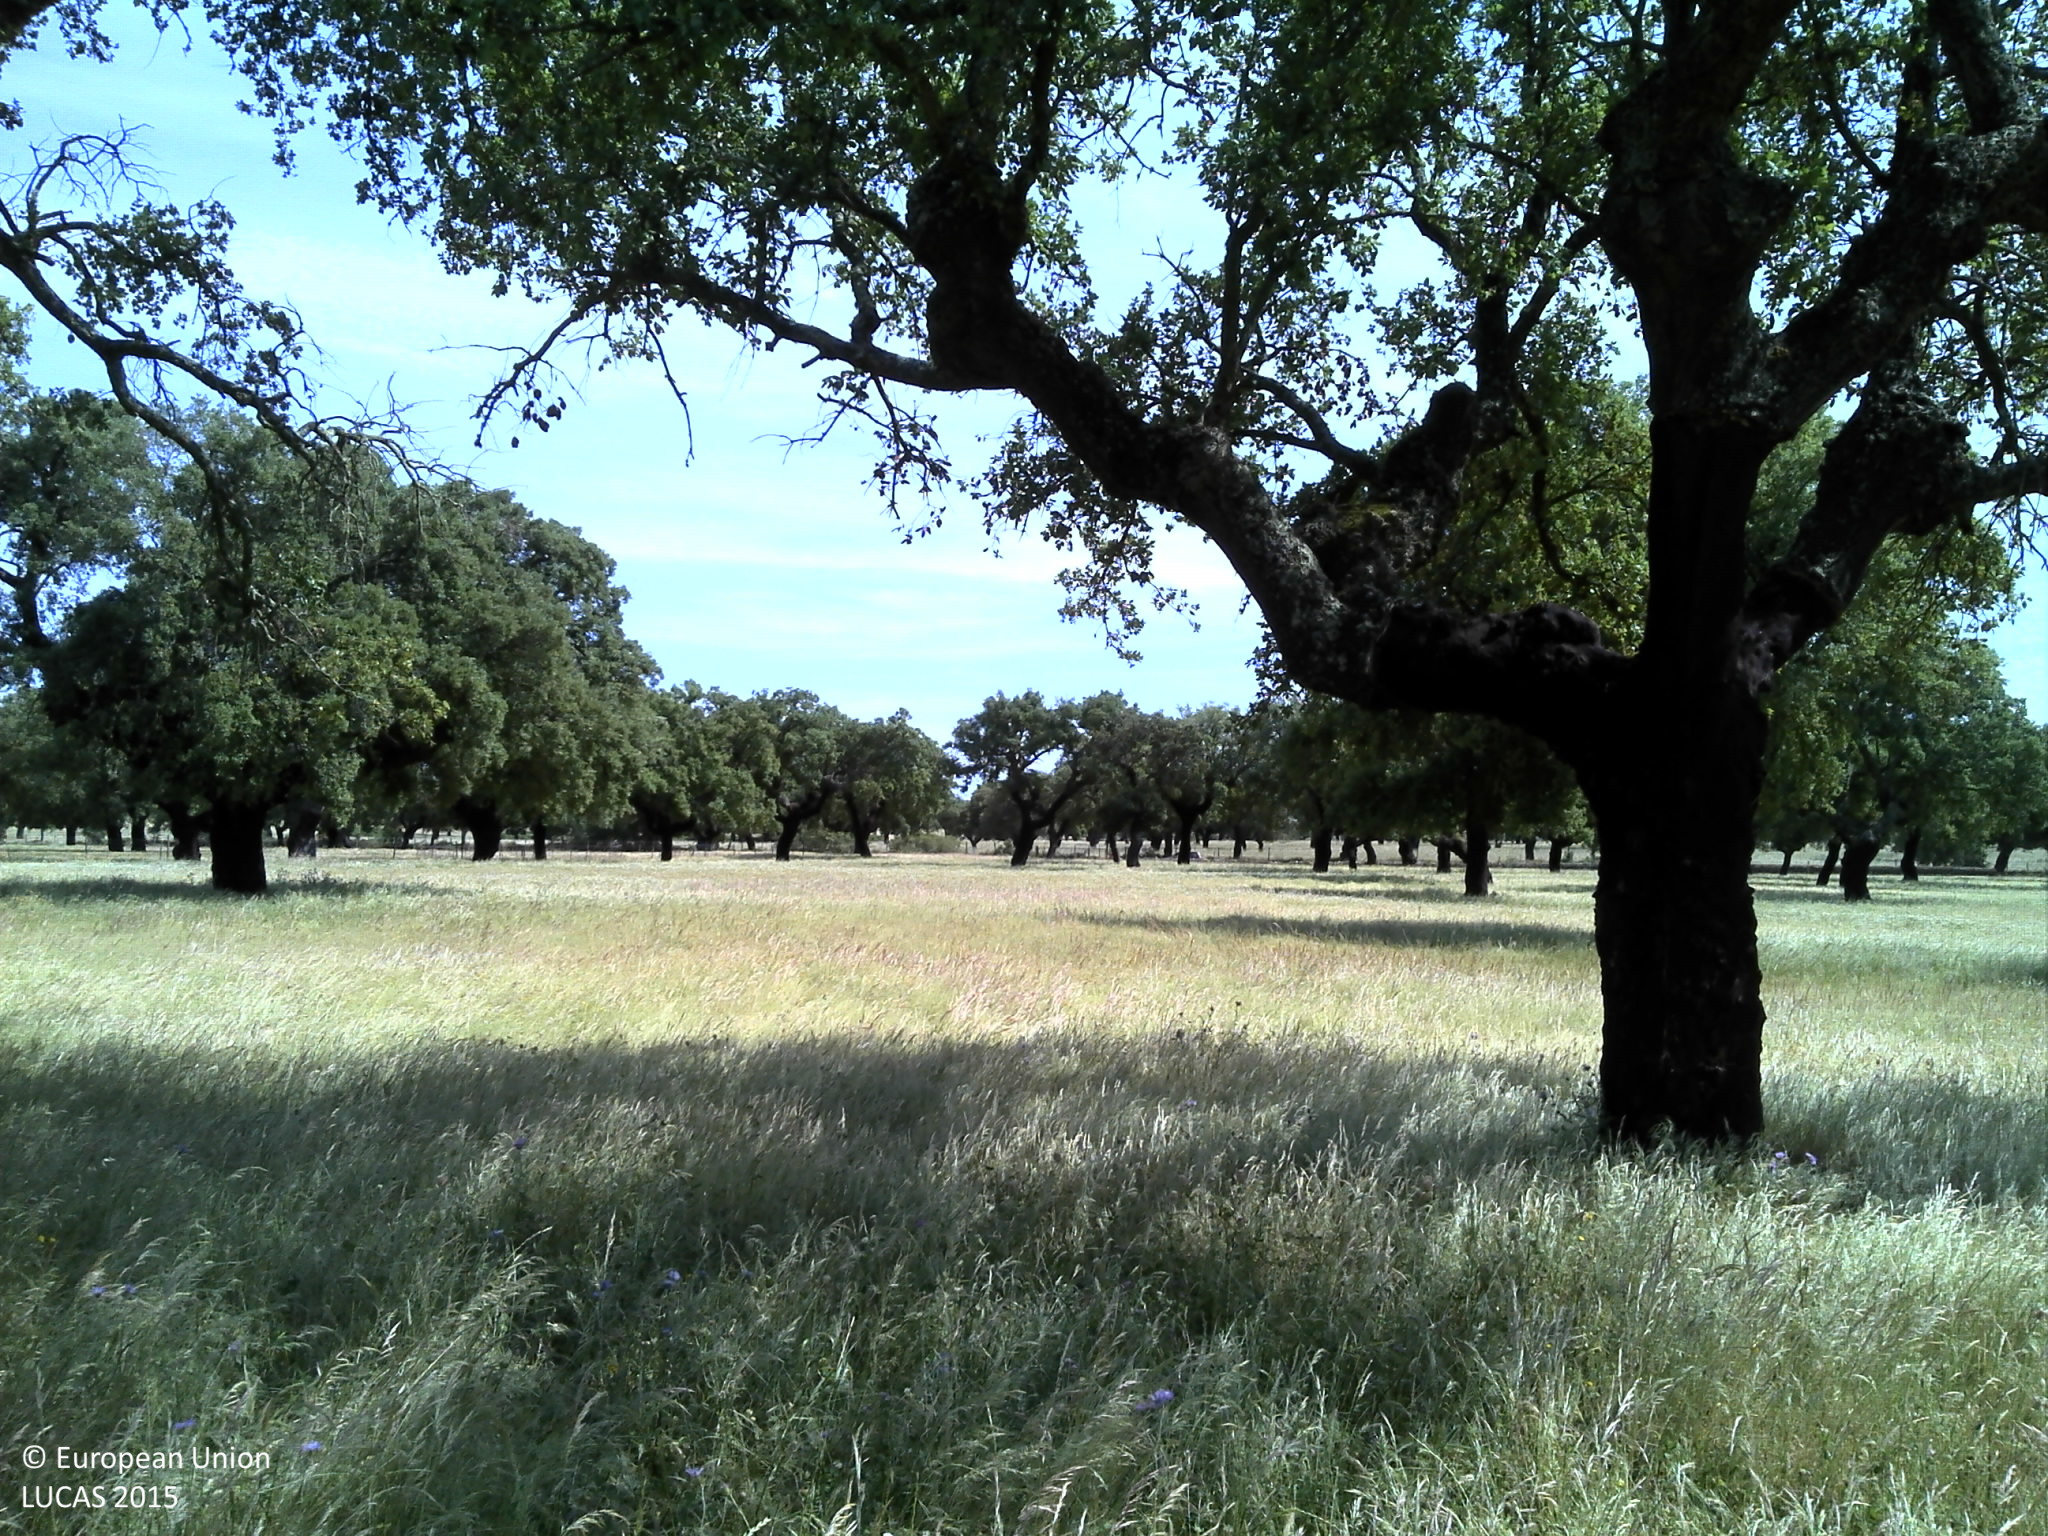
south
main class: Woodland
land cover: Broadleaved woodland
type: broadleaved evergreen forest
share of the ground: 25 - 50 %
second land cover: Grassland without tree/shrub cover
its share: 50 - 75 %
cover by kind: herbaceous plants 50 %, broadleaved forest trees 40 %, unconsolidated bare surface 10 %
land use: Forestry
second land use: Agriculture (excluding fallow land and kitchen gardens)
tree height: > 5 m
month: May
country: PT
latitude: 39.2094
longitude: -7.6362
